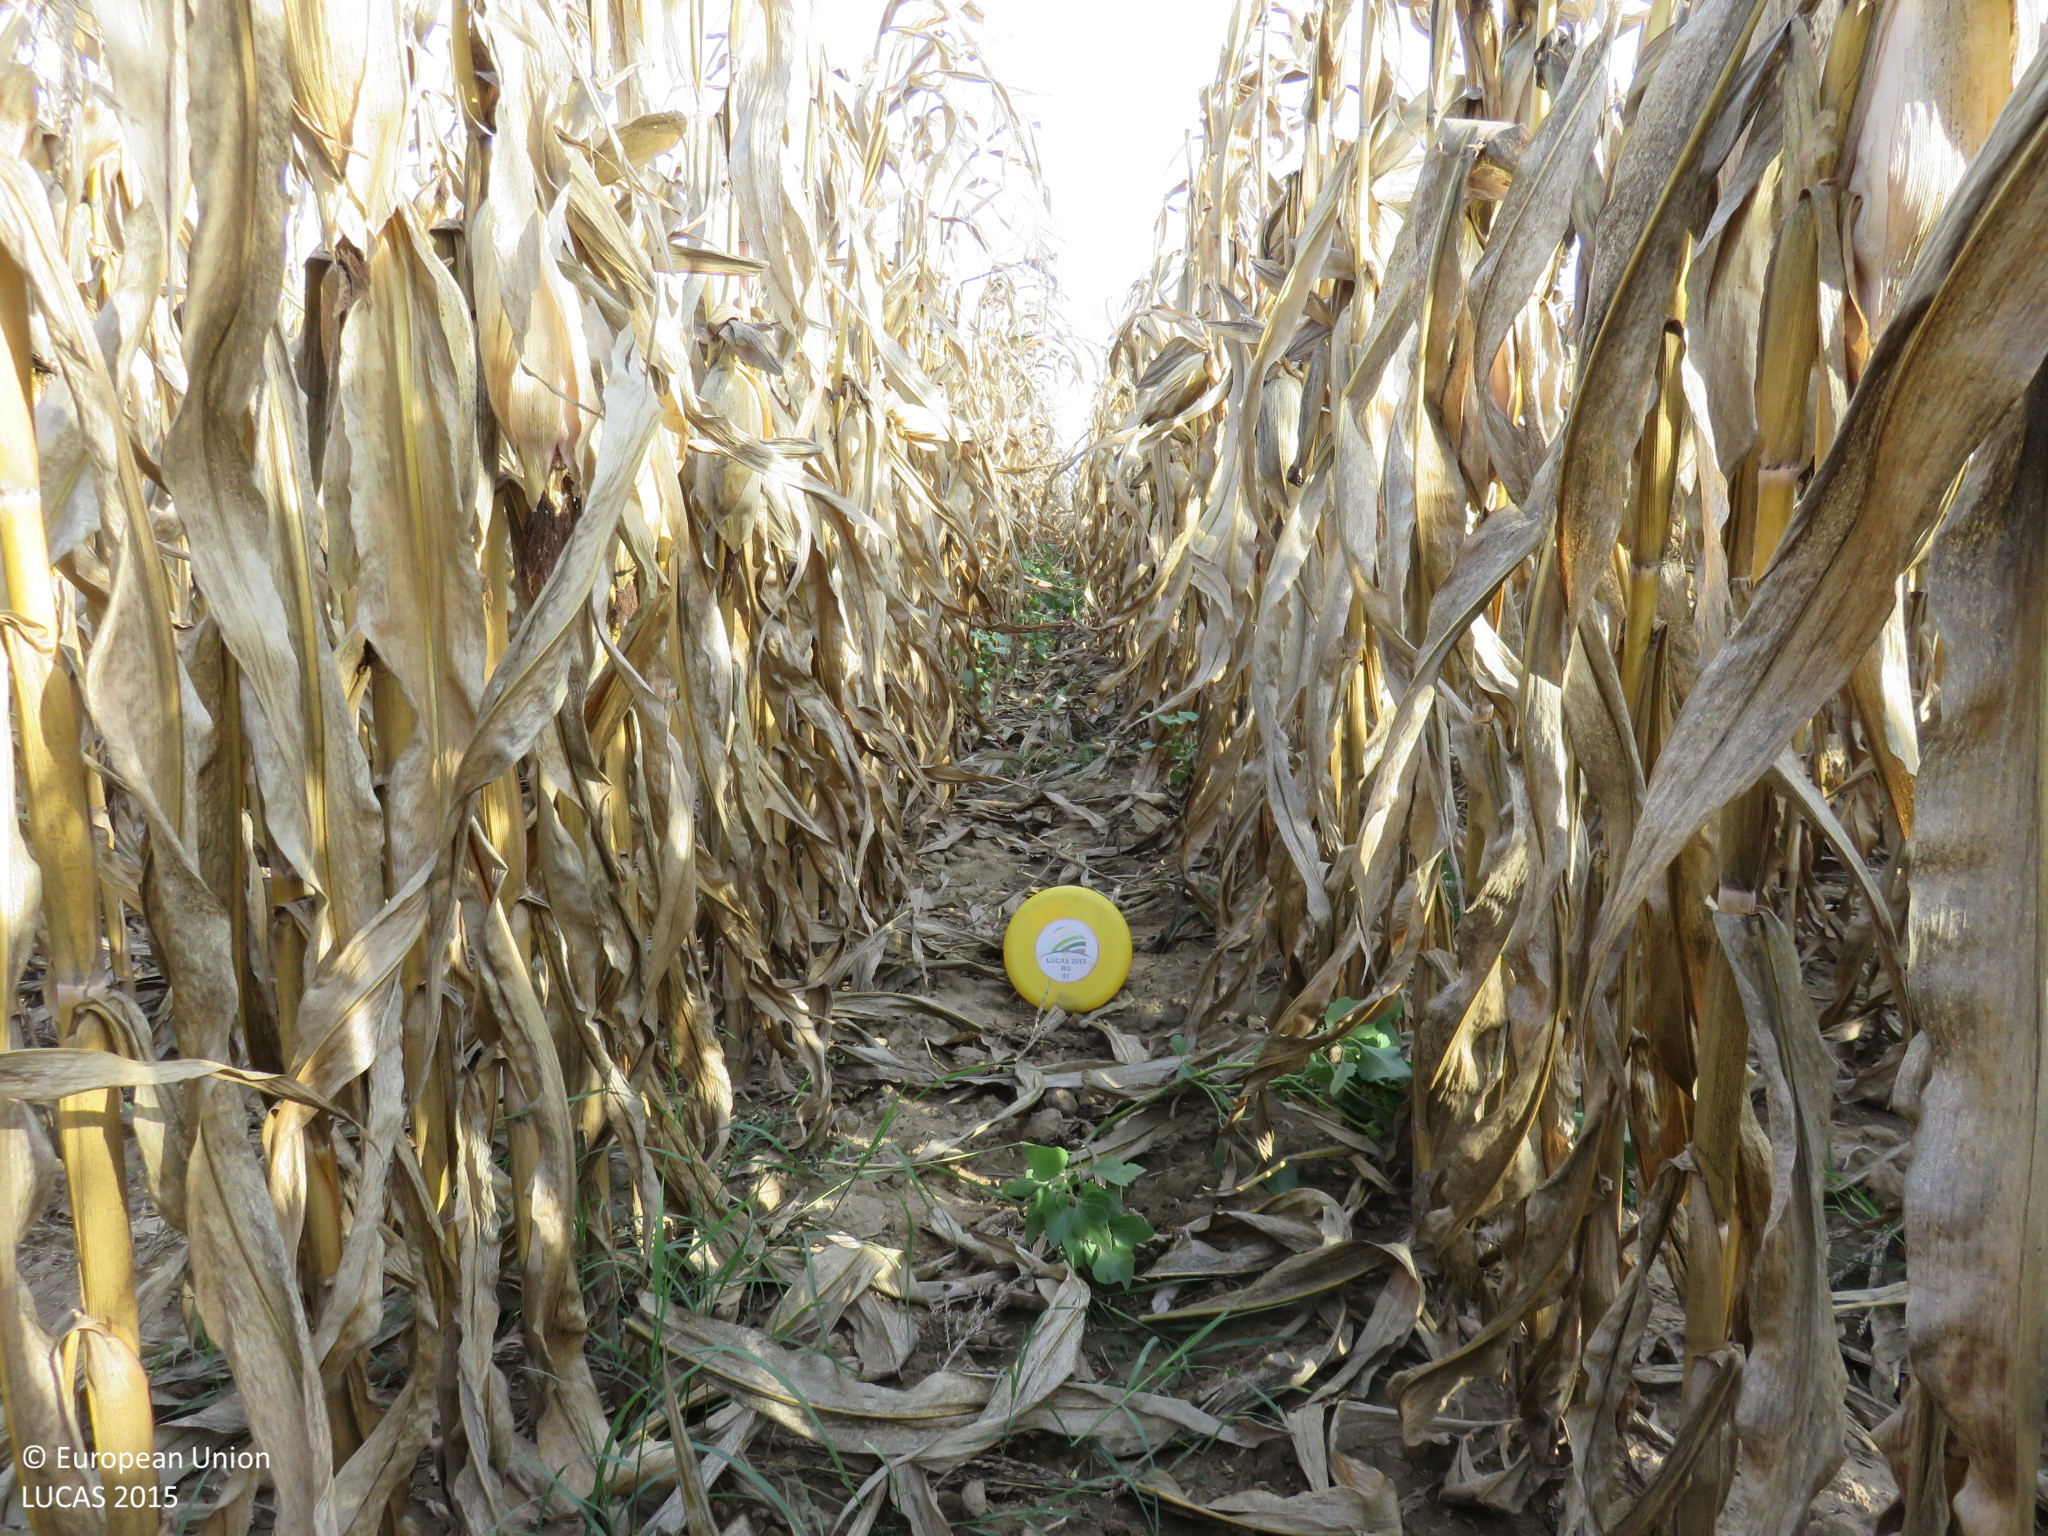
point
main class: Cropland
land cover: Maize
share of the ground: > 75 %
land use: Agriculture (excluding fallow land and kitchen gardens)
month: September
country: BG
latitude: 43.7282
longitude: 24.5018
